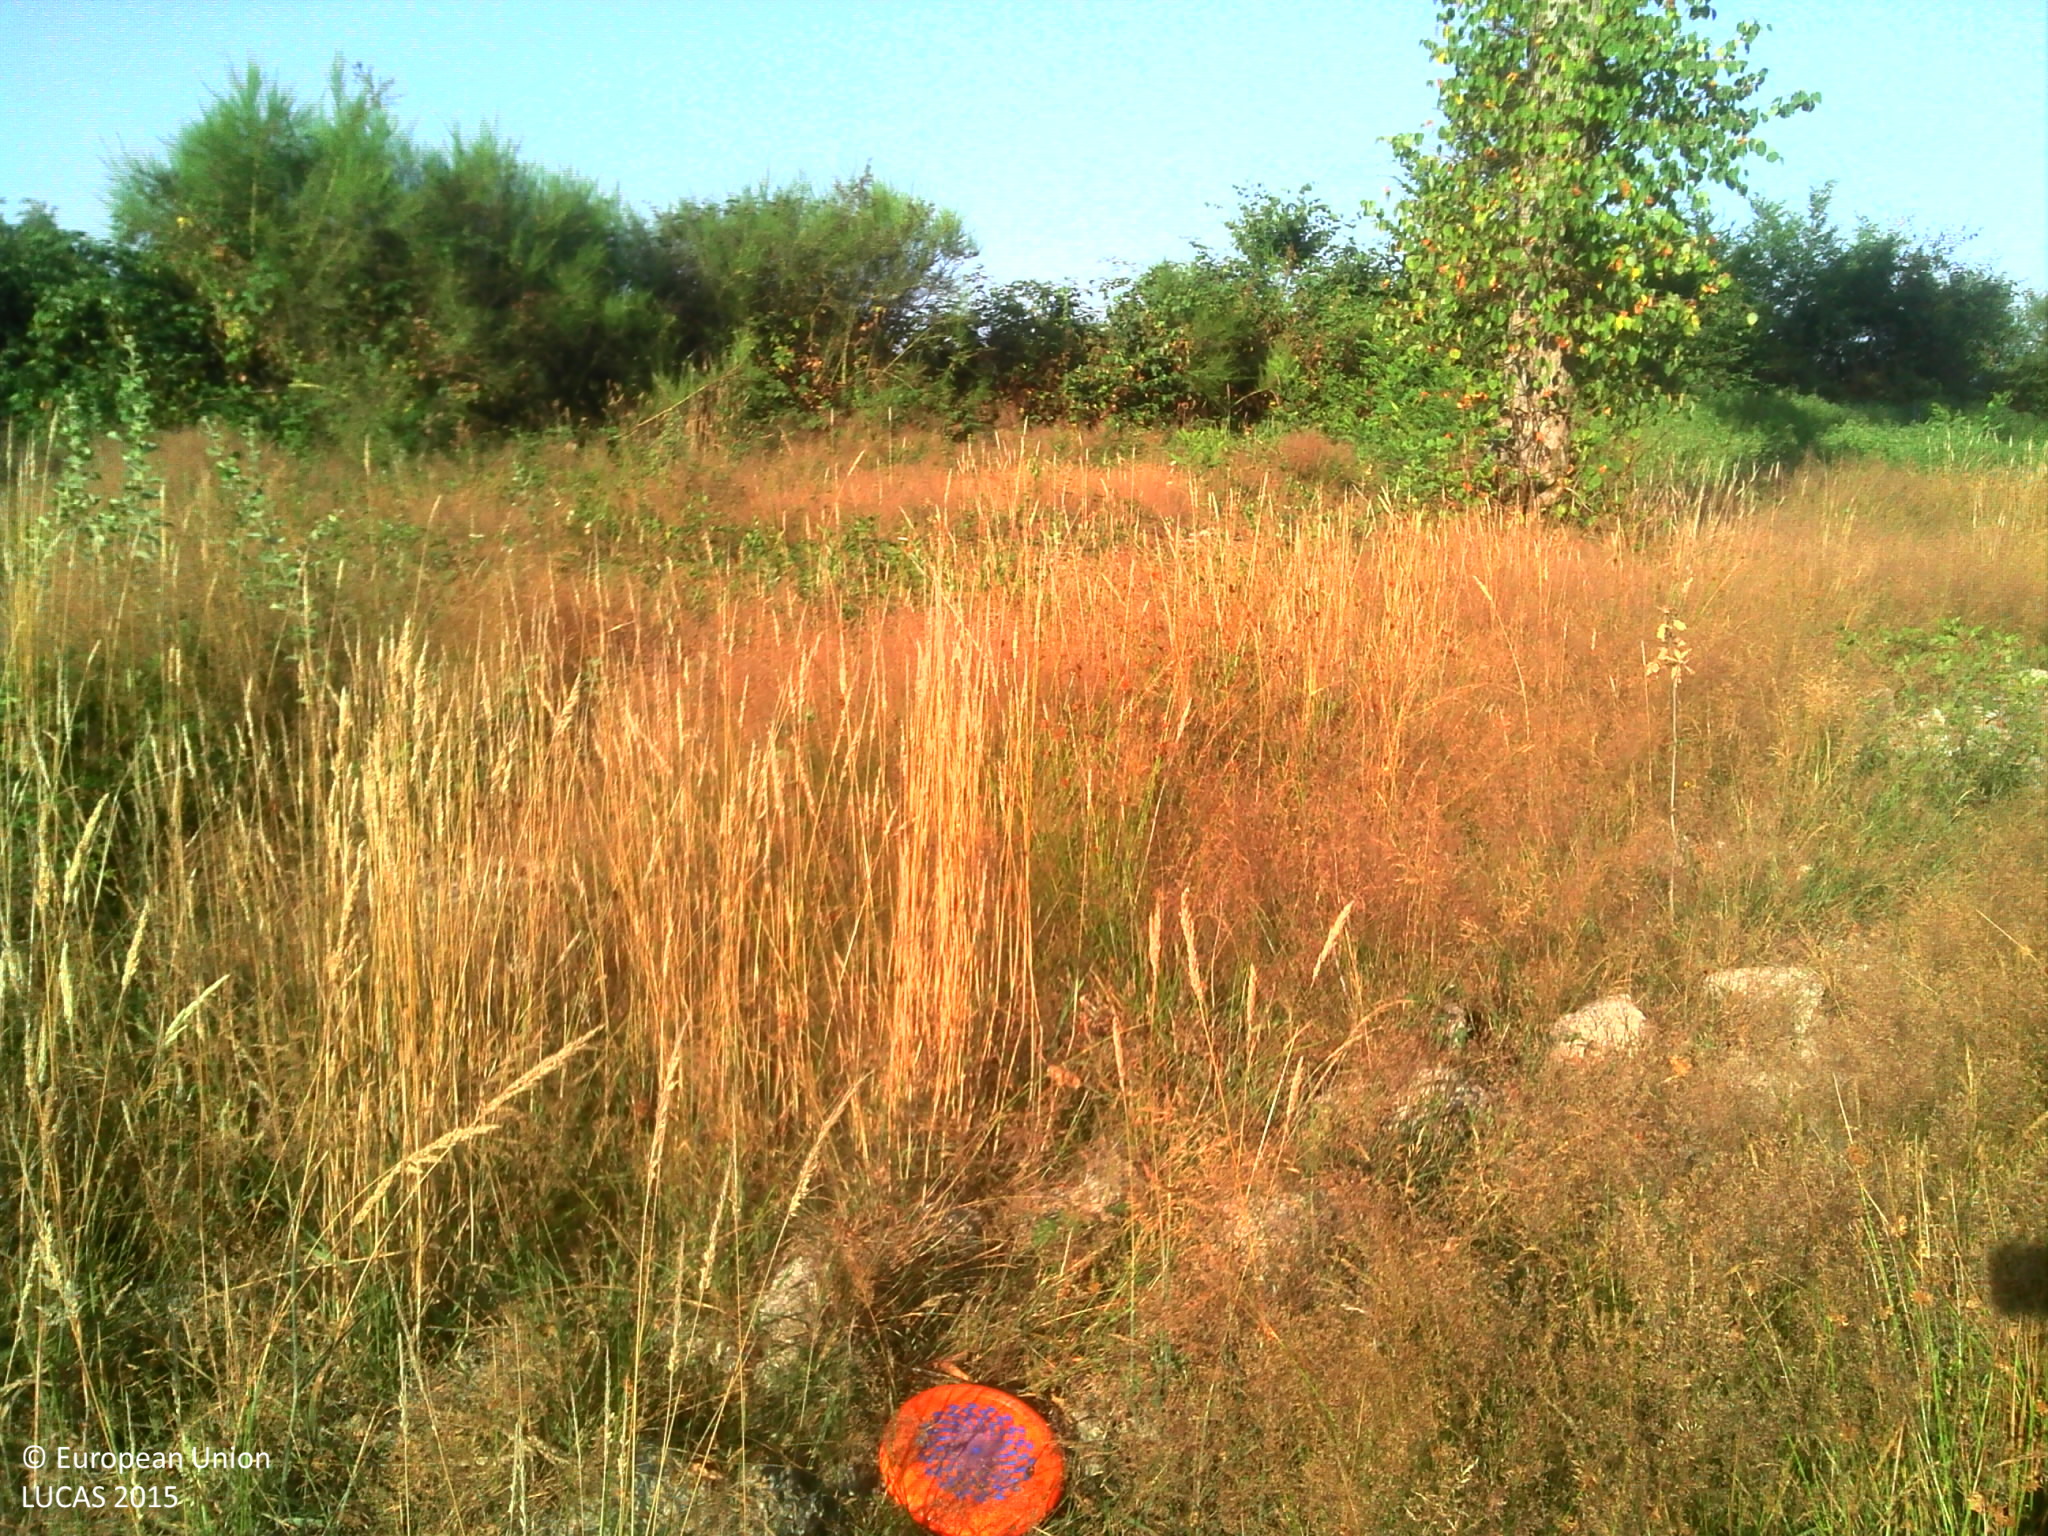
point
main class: Woodland
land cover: Broadleaved woodland
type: mesophytic deciduous forest
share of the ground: > 75 %
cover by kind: broadleaved forest trees 90 %, shrubs 10 %
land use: Forestry
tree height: > 5 m
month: July
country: FR
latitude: 46.7989
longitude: 5.1145
